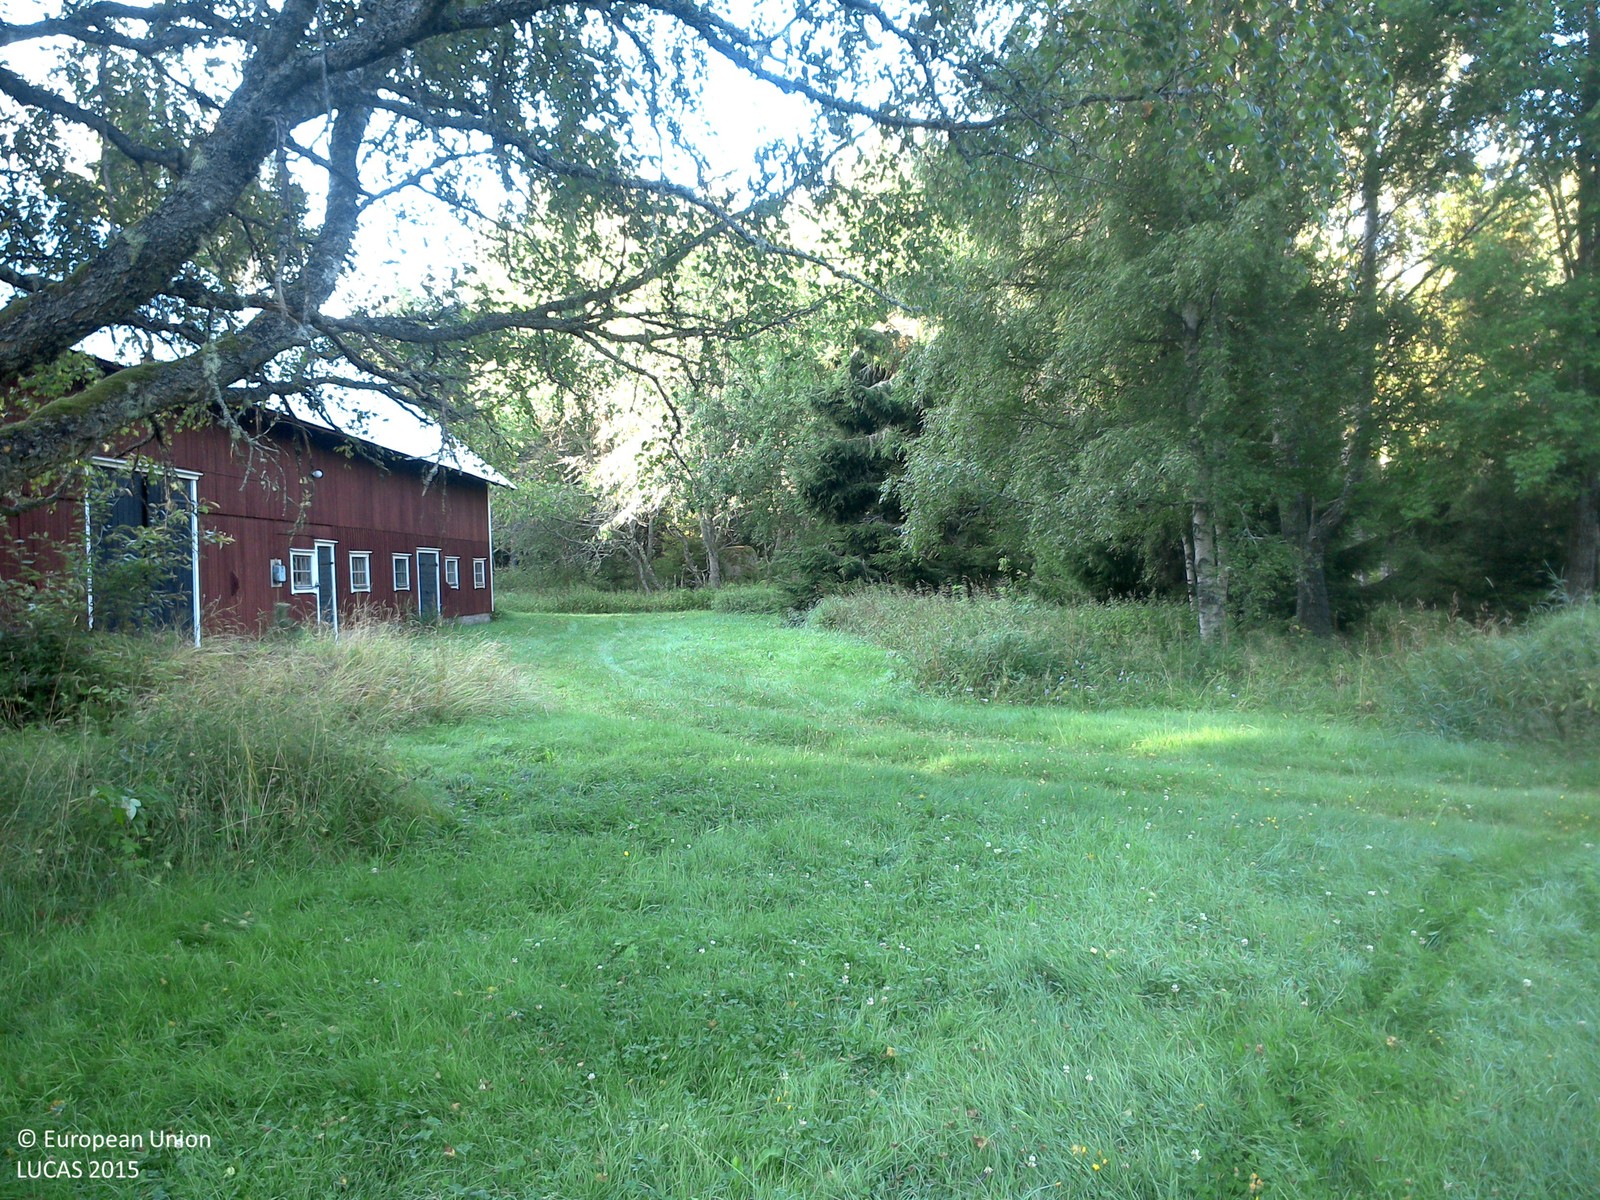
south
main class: Grassland
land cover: Grassland with sparse tree/shrub cover
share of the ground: > 75 %
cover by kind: herbaceous plants 95 %, broadleaved forest trees 5 %
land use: Residential
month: August
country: SE
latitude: 57.7935
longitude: 15.6655
